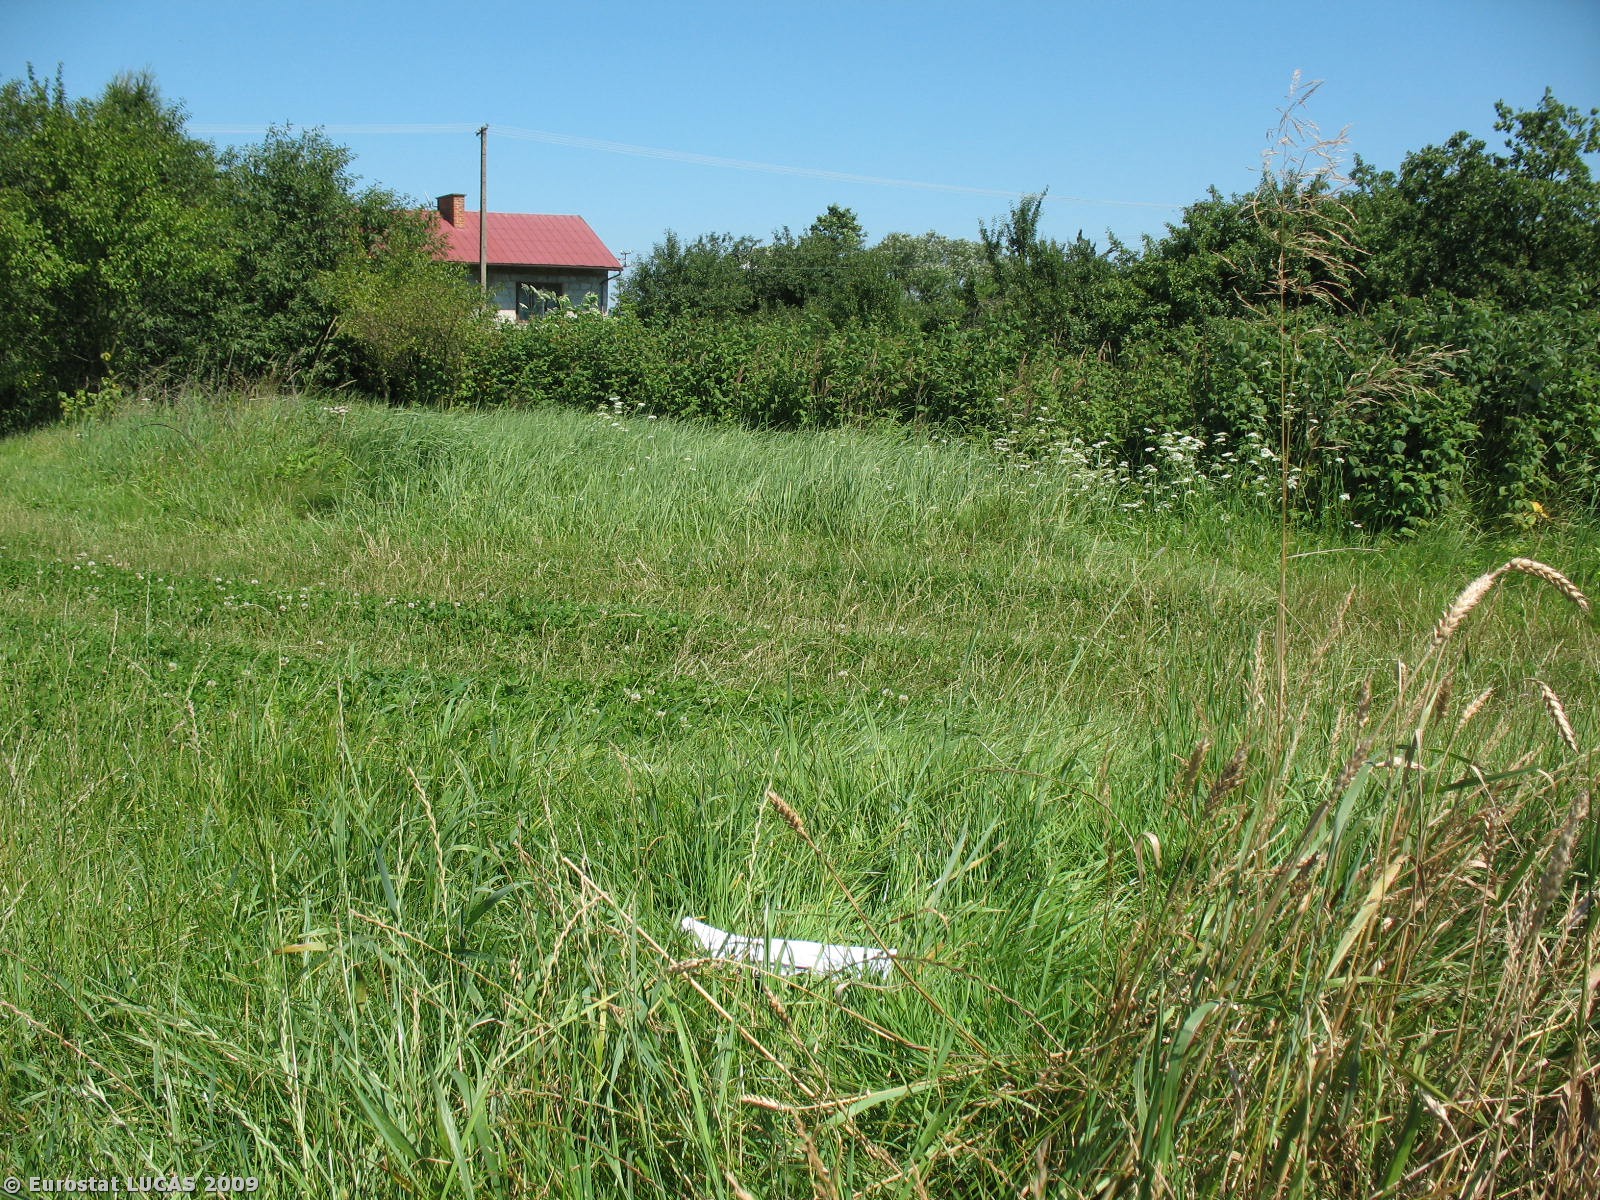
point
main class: Grassland
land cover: Grassland without tree/shrub cover
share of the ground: > 75 %
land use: Agriculture (excluding fallow land and kitchen gardens)
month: July
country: PL
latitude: 49.7146
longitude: 21.9699
